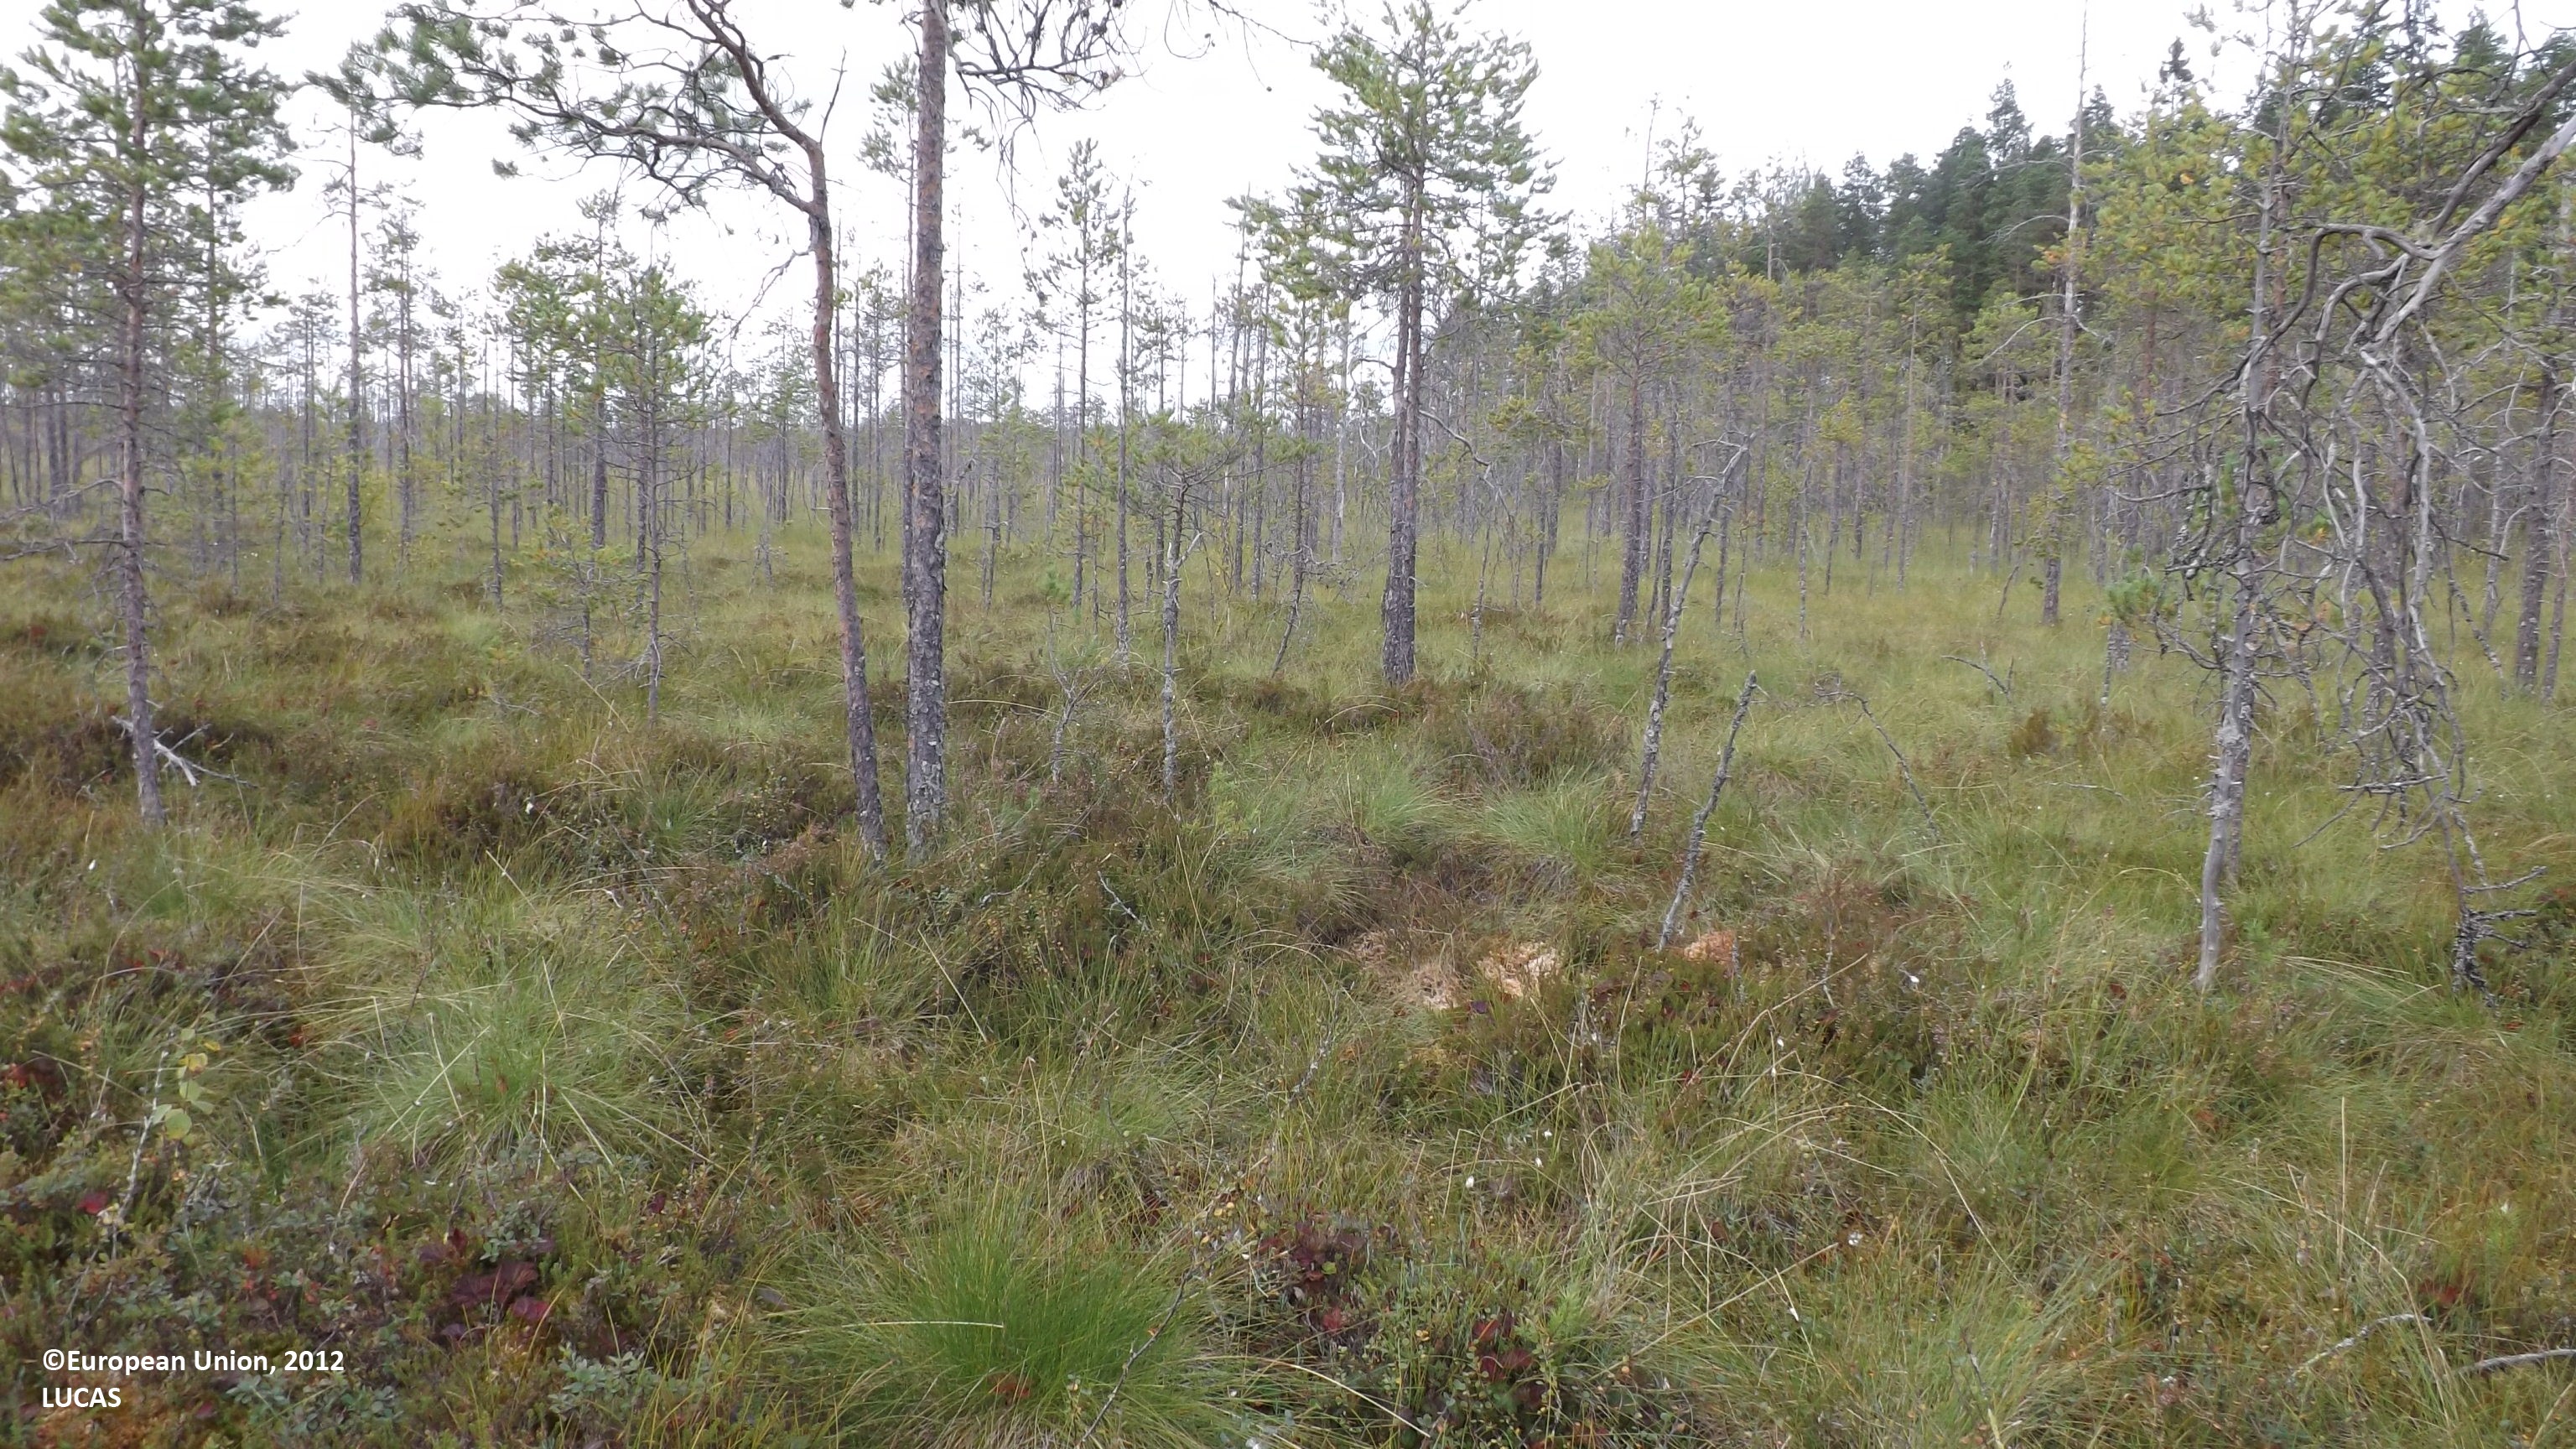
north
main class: Woodland
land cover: Pine dominated coniferous woodland
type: mire and swamp forests
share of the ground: 10 - 25 %
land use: Semi-natural and natural areas not in use
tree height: > 5 m
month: August
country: FI
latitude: 63.7839
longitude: 24.0892
